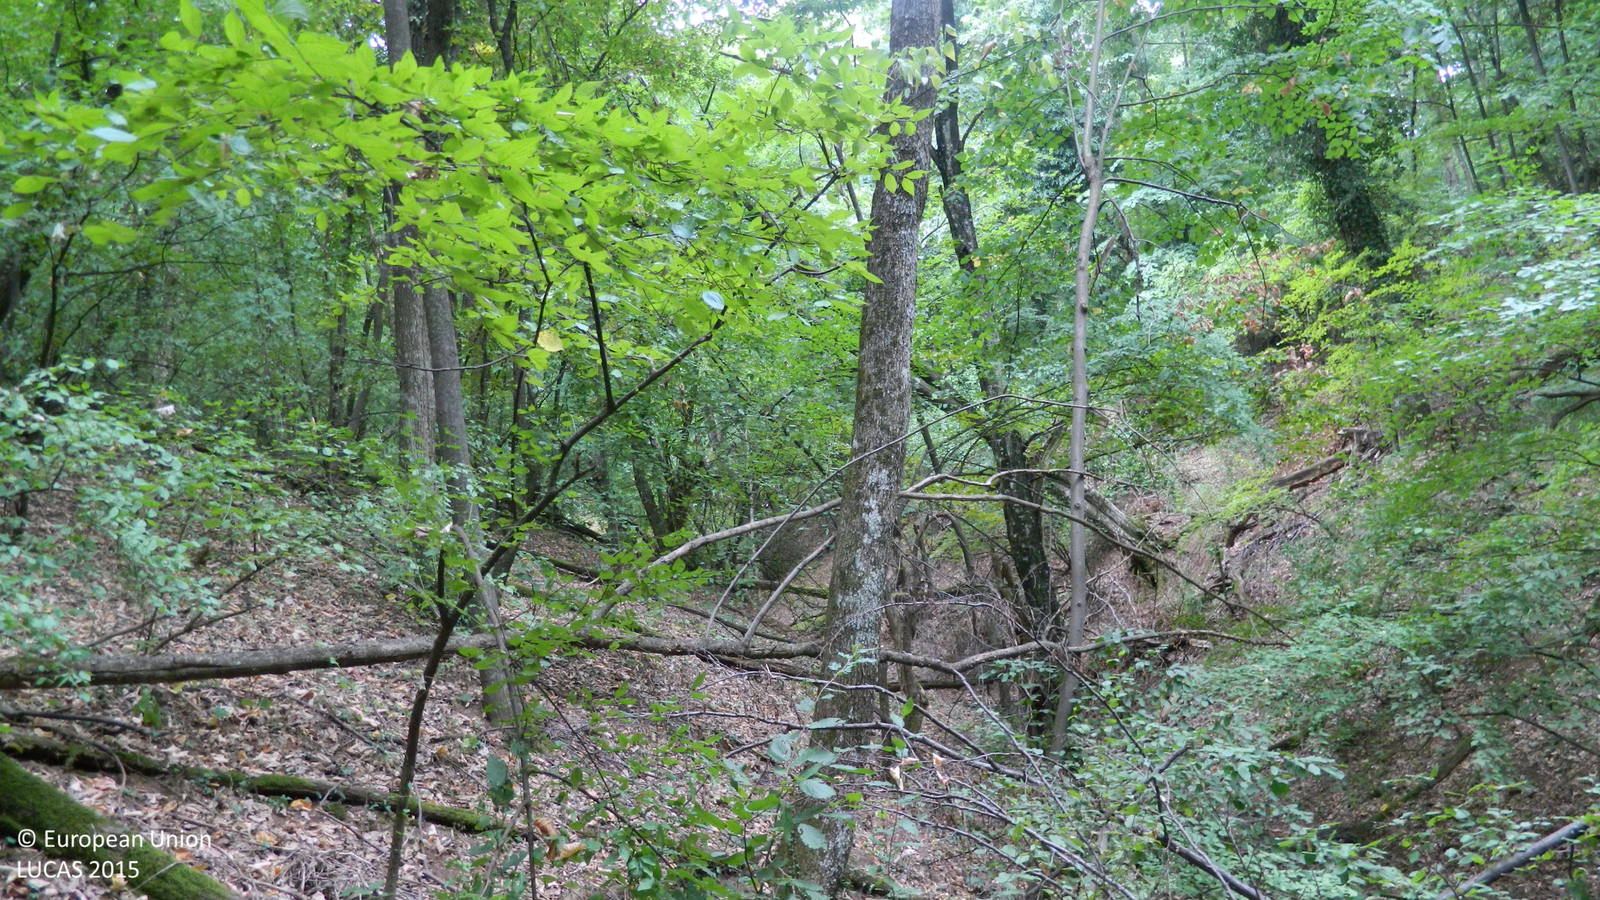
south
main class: Woodland
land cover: Broadleaved woodland
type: mesophytic deciduous forest
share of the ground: > 75 %
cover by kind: broadleaved forest trees 100 %
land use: Forestry
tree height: > 5 m
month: August
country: BG
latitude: 41.7309
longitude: 25.8284
